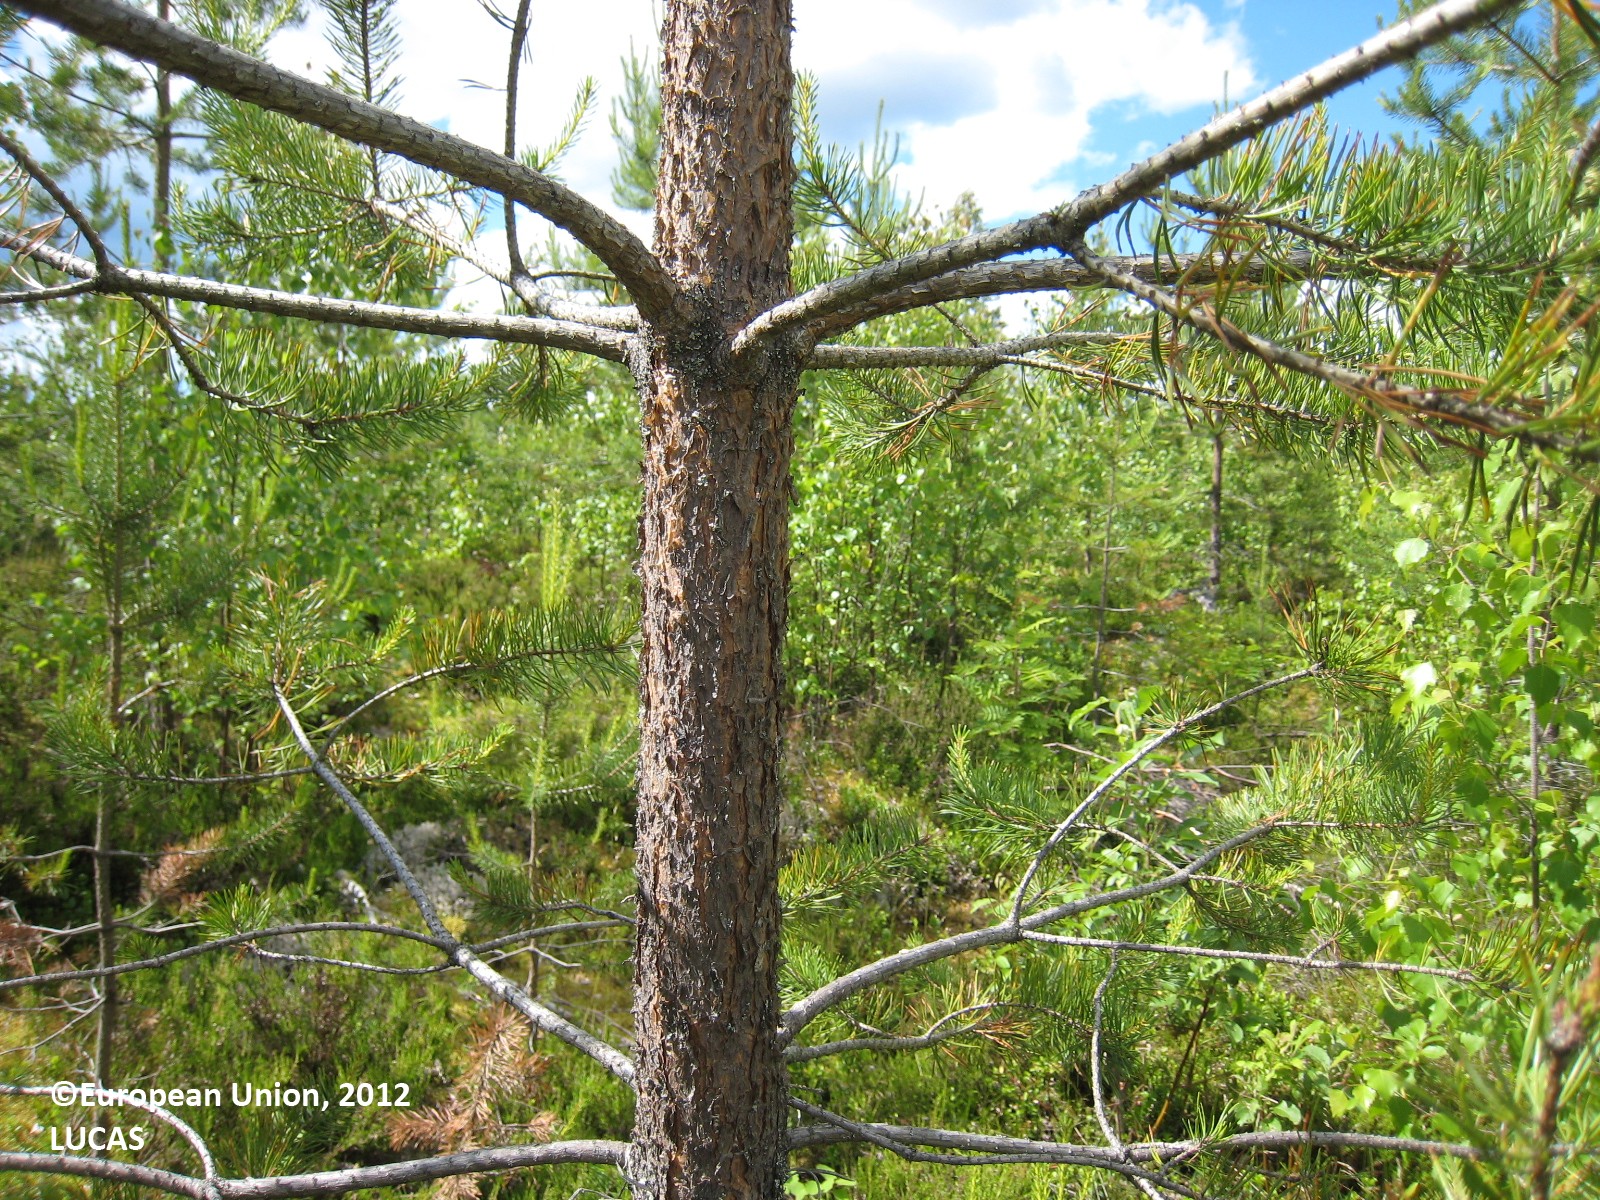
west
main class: Woodland
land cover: Pine dominated mixed woodland
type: boreal forest
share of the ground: 50 - 75 %
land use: Forestry
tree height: < 5 m
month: July
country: FI
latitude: 62.8351
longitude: 25.6818
